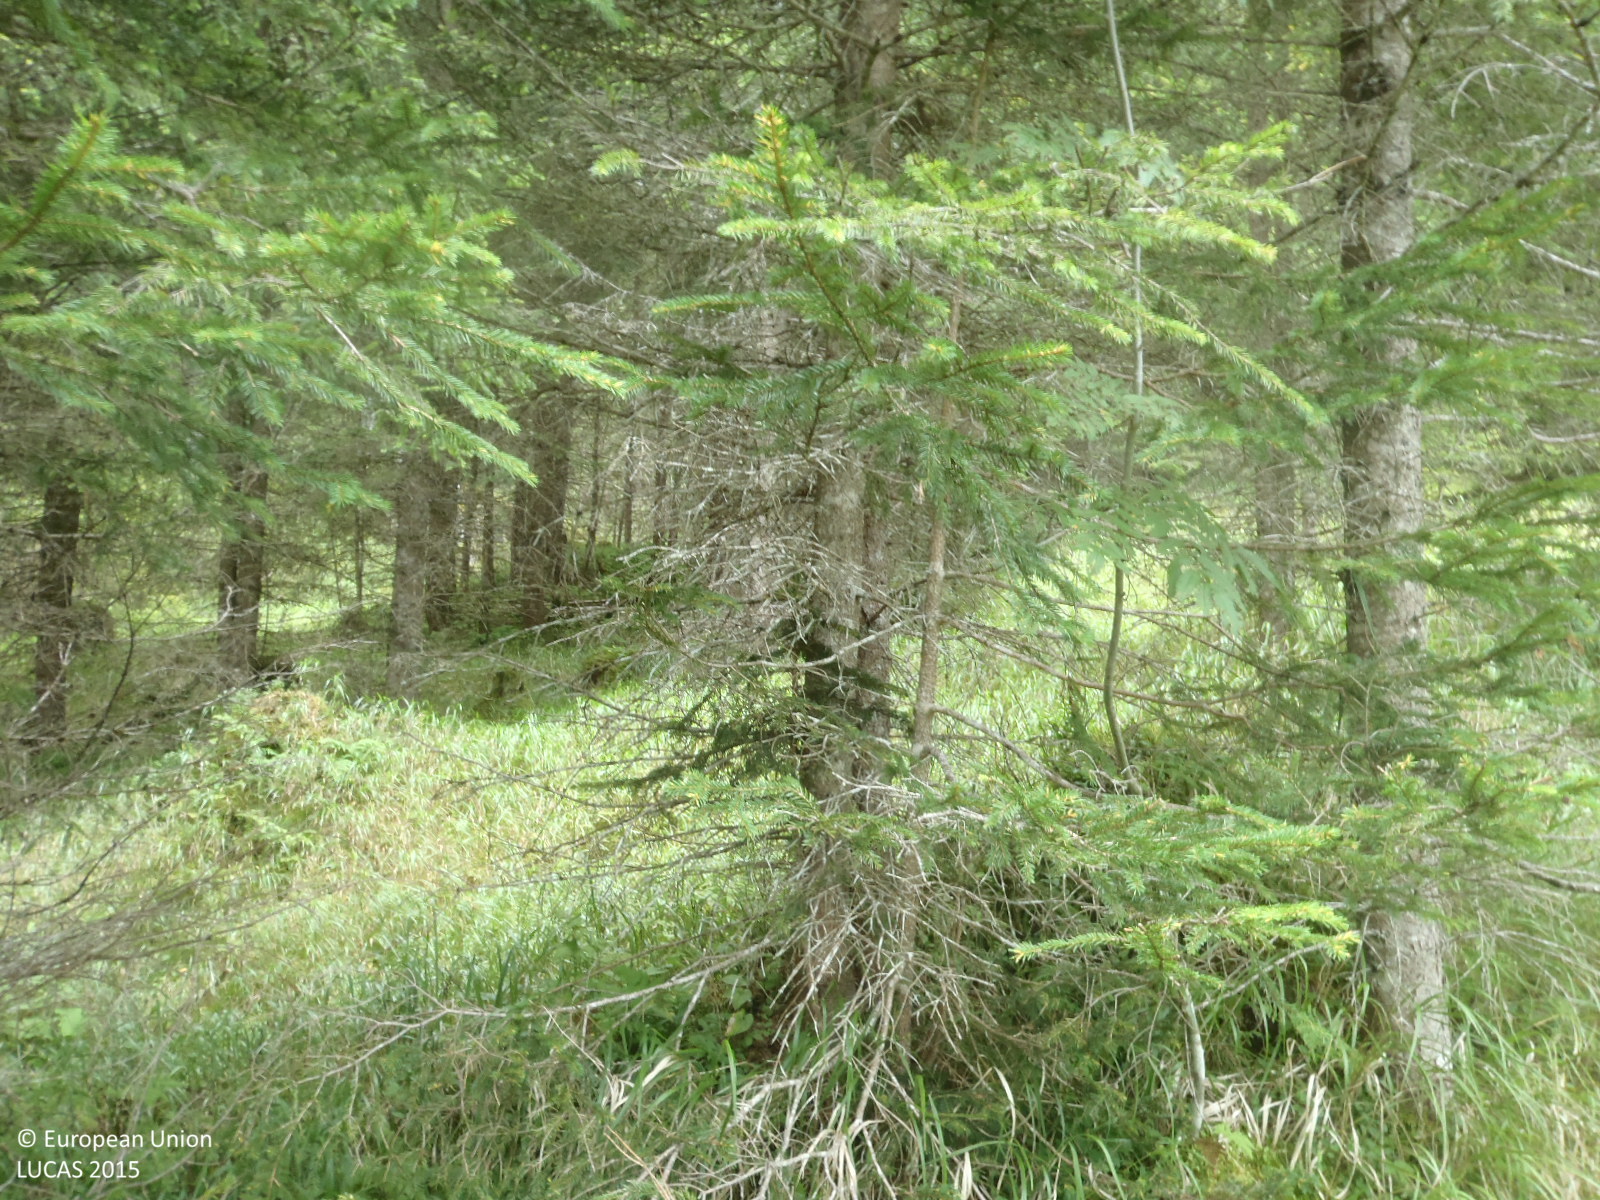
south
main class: Woodland
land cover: Spruce dominated coniferous woodland
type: alpine coniferous forest
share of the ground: > 75 %
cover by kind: coniferous forest trees 95 %, herbaceous plants 5 %
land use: Forestry
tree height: > 5 m
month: August
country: AT
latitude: 46.9183
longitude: 12.4271
